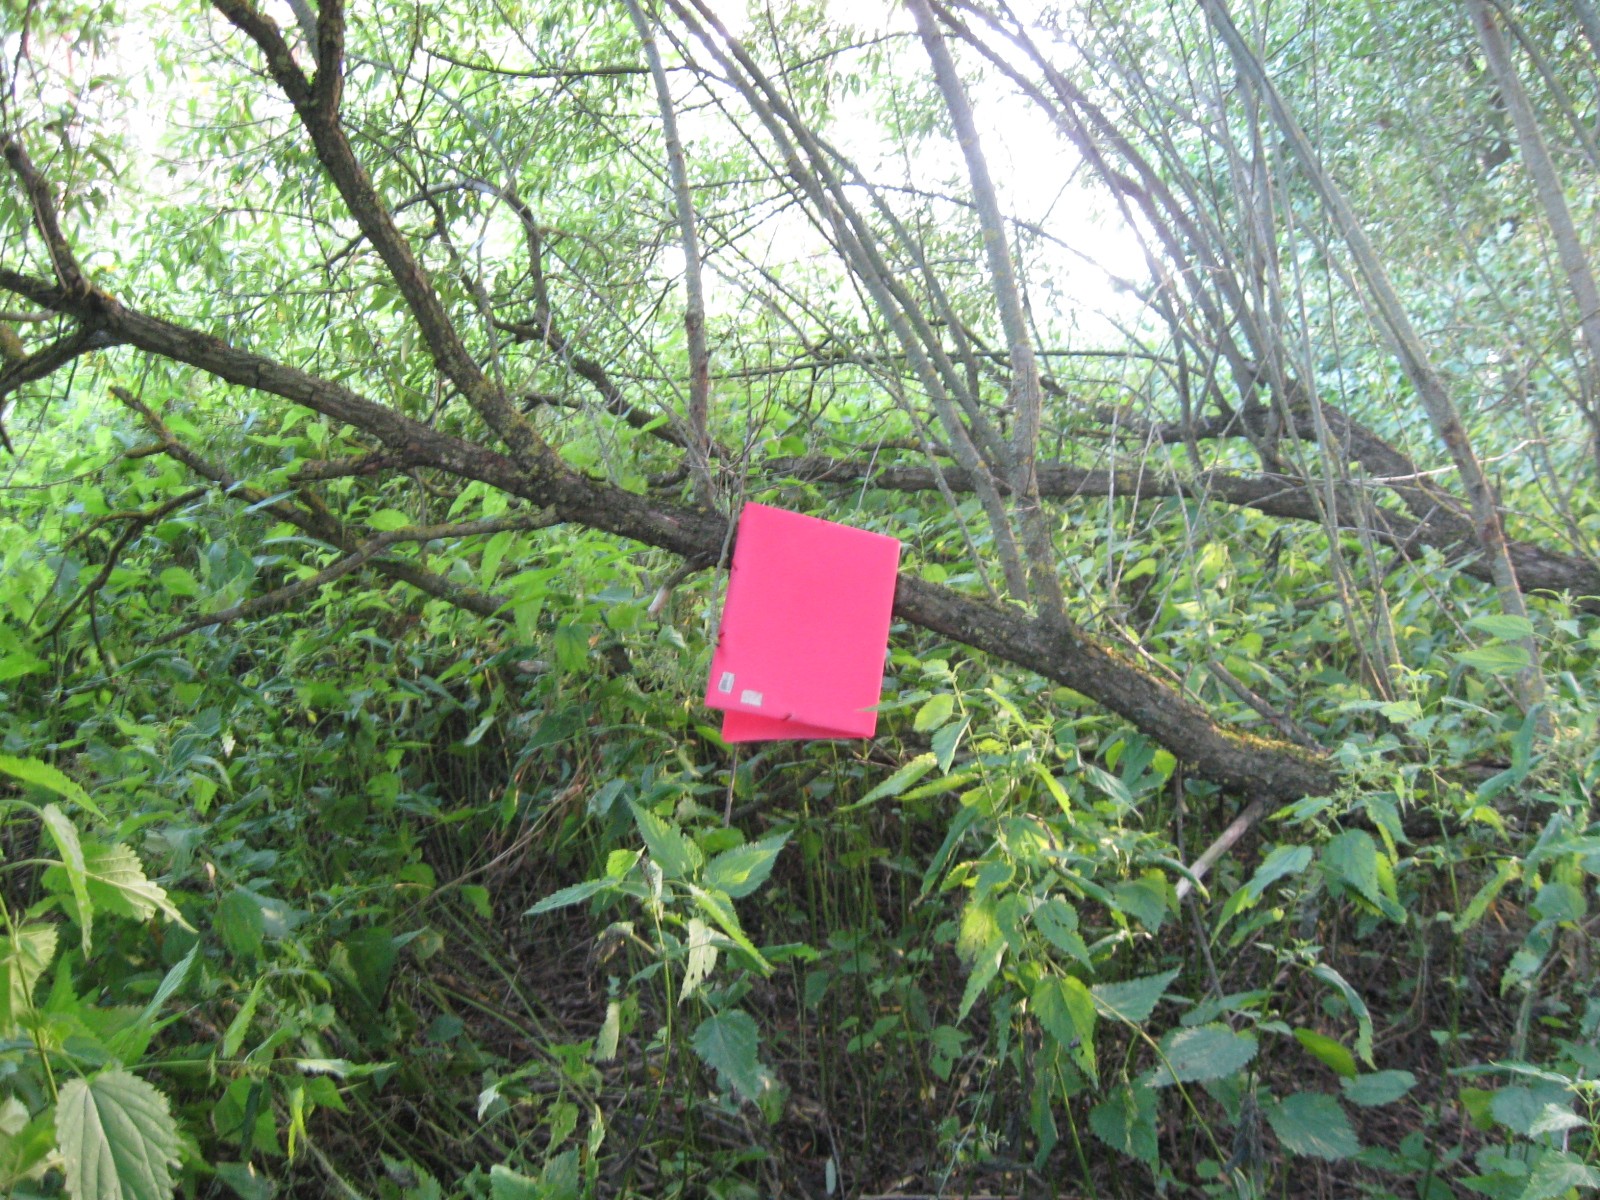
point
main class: Woodland
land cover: Broadleaved woodland
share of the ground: > 75 %
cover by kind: broadleaved forest trees 80 %, herbaceous plants 20 %
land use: Semi-natural and natural areas not in use
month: July
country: LT
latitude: 54.3338
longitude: 23.5397
